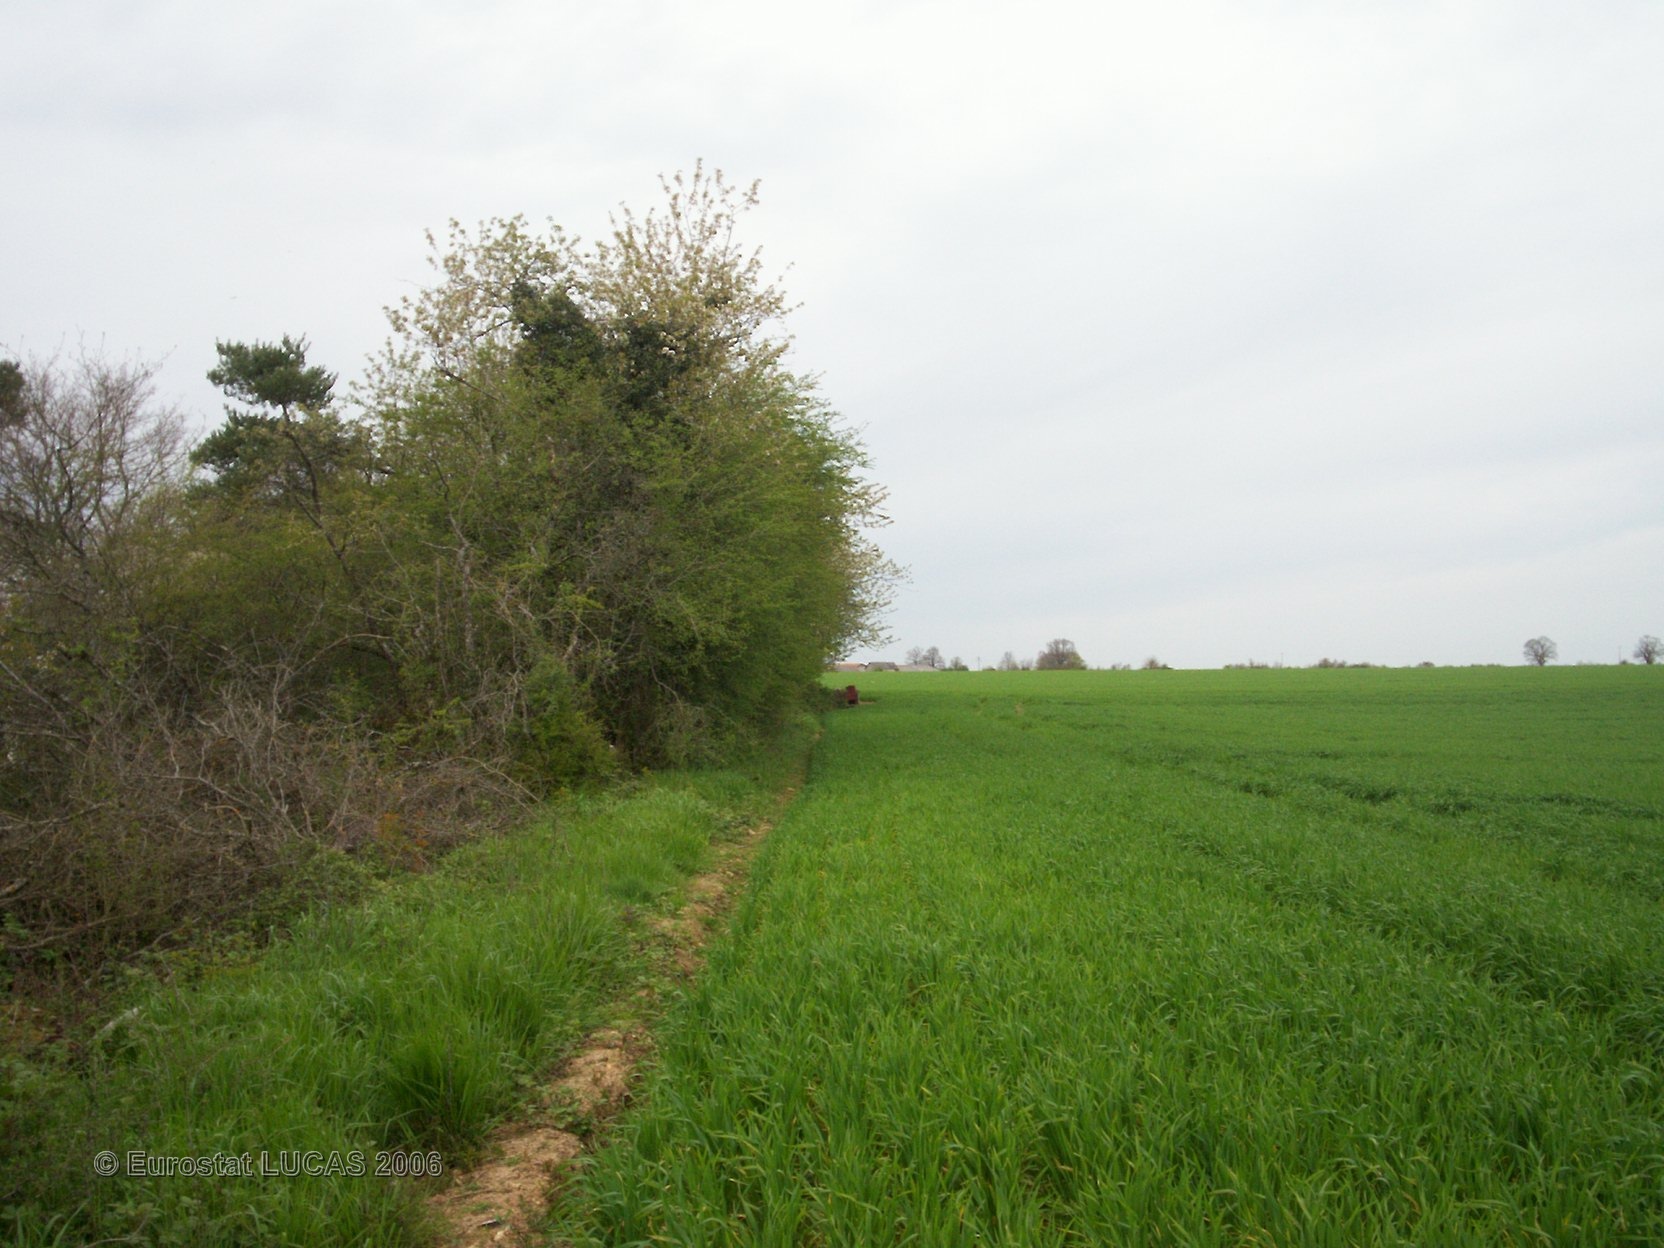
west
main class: Cropland
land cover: Common wheat
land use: Agriculture (excluding fallow land and kitchen gardens)
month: April
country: FR
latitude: 46.1780
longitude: 0.4624
